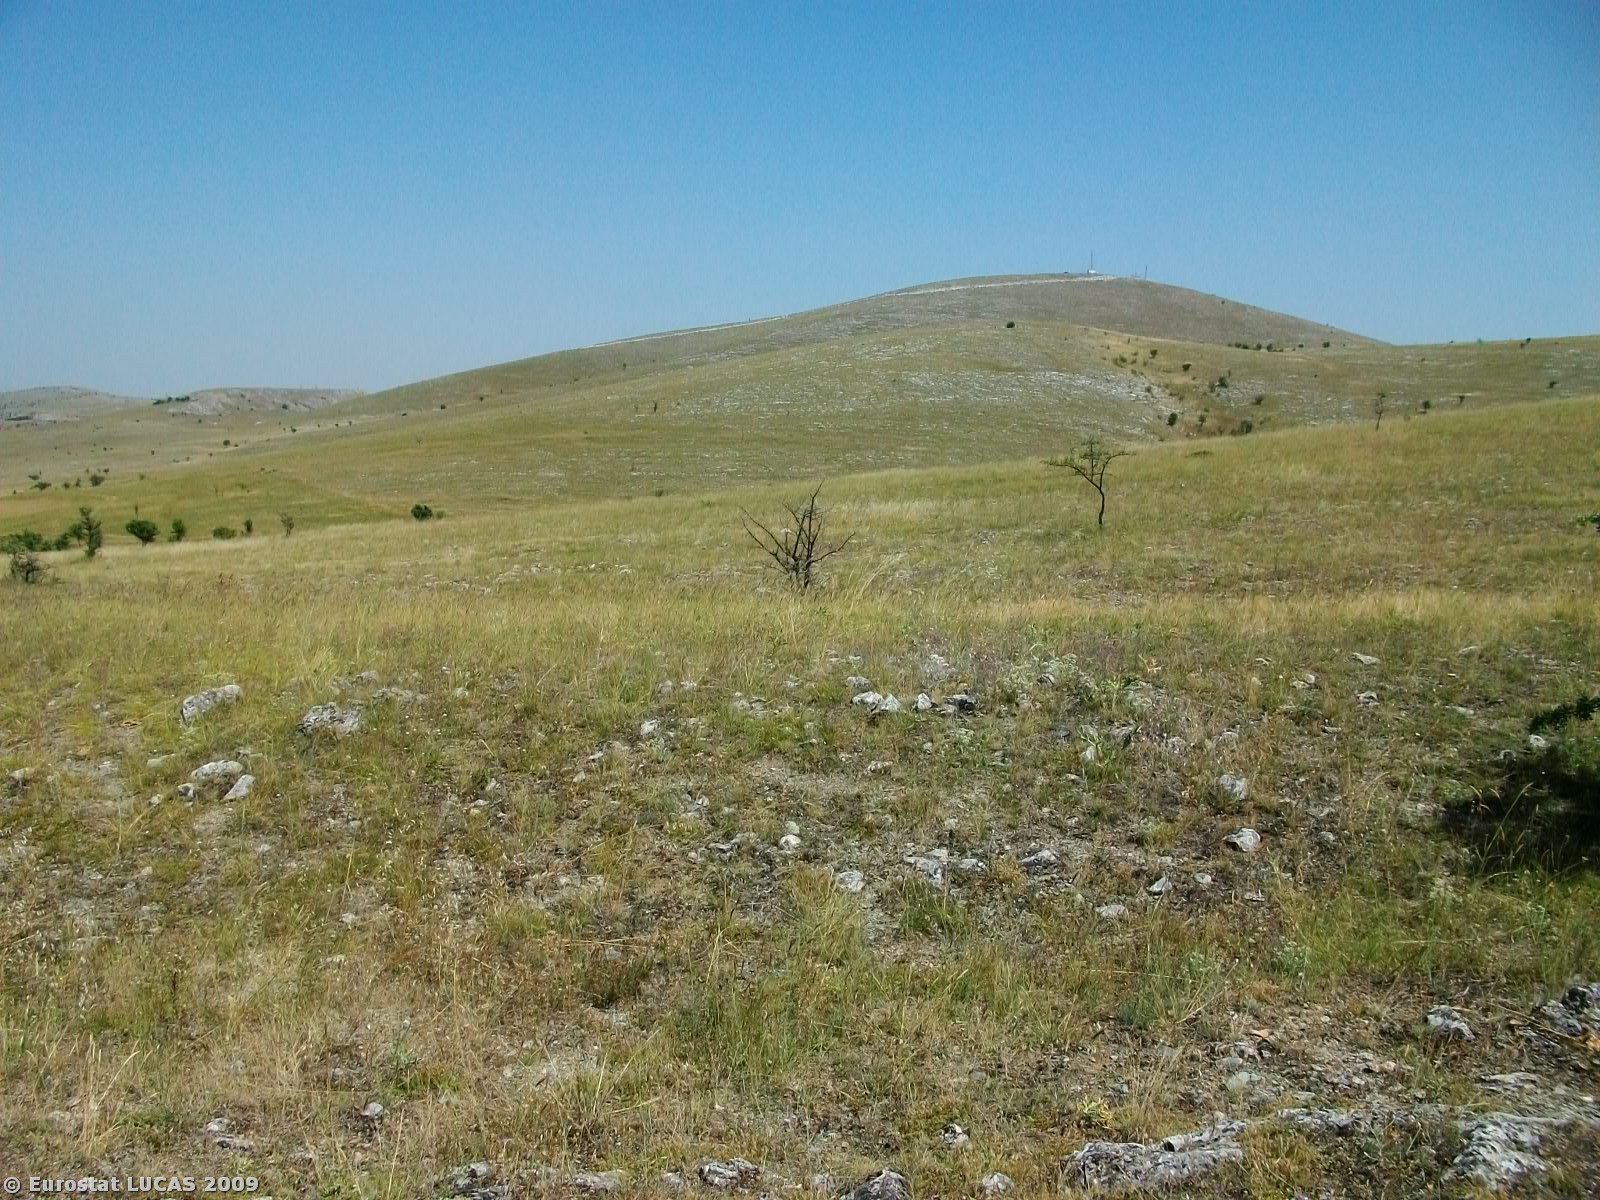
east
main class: Grassland
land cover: Grassland without tree/shrub cover
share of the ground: > 75 %
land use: Unused
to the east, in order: Grassland without tree/shrub cover; Tracks; Grassland without tree/shrub cover; Single bushes/trees; Grassland without tree/shrub cover
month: July
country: GR
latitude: 40.3436
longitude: 21.7527
